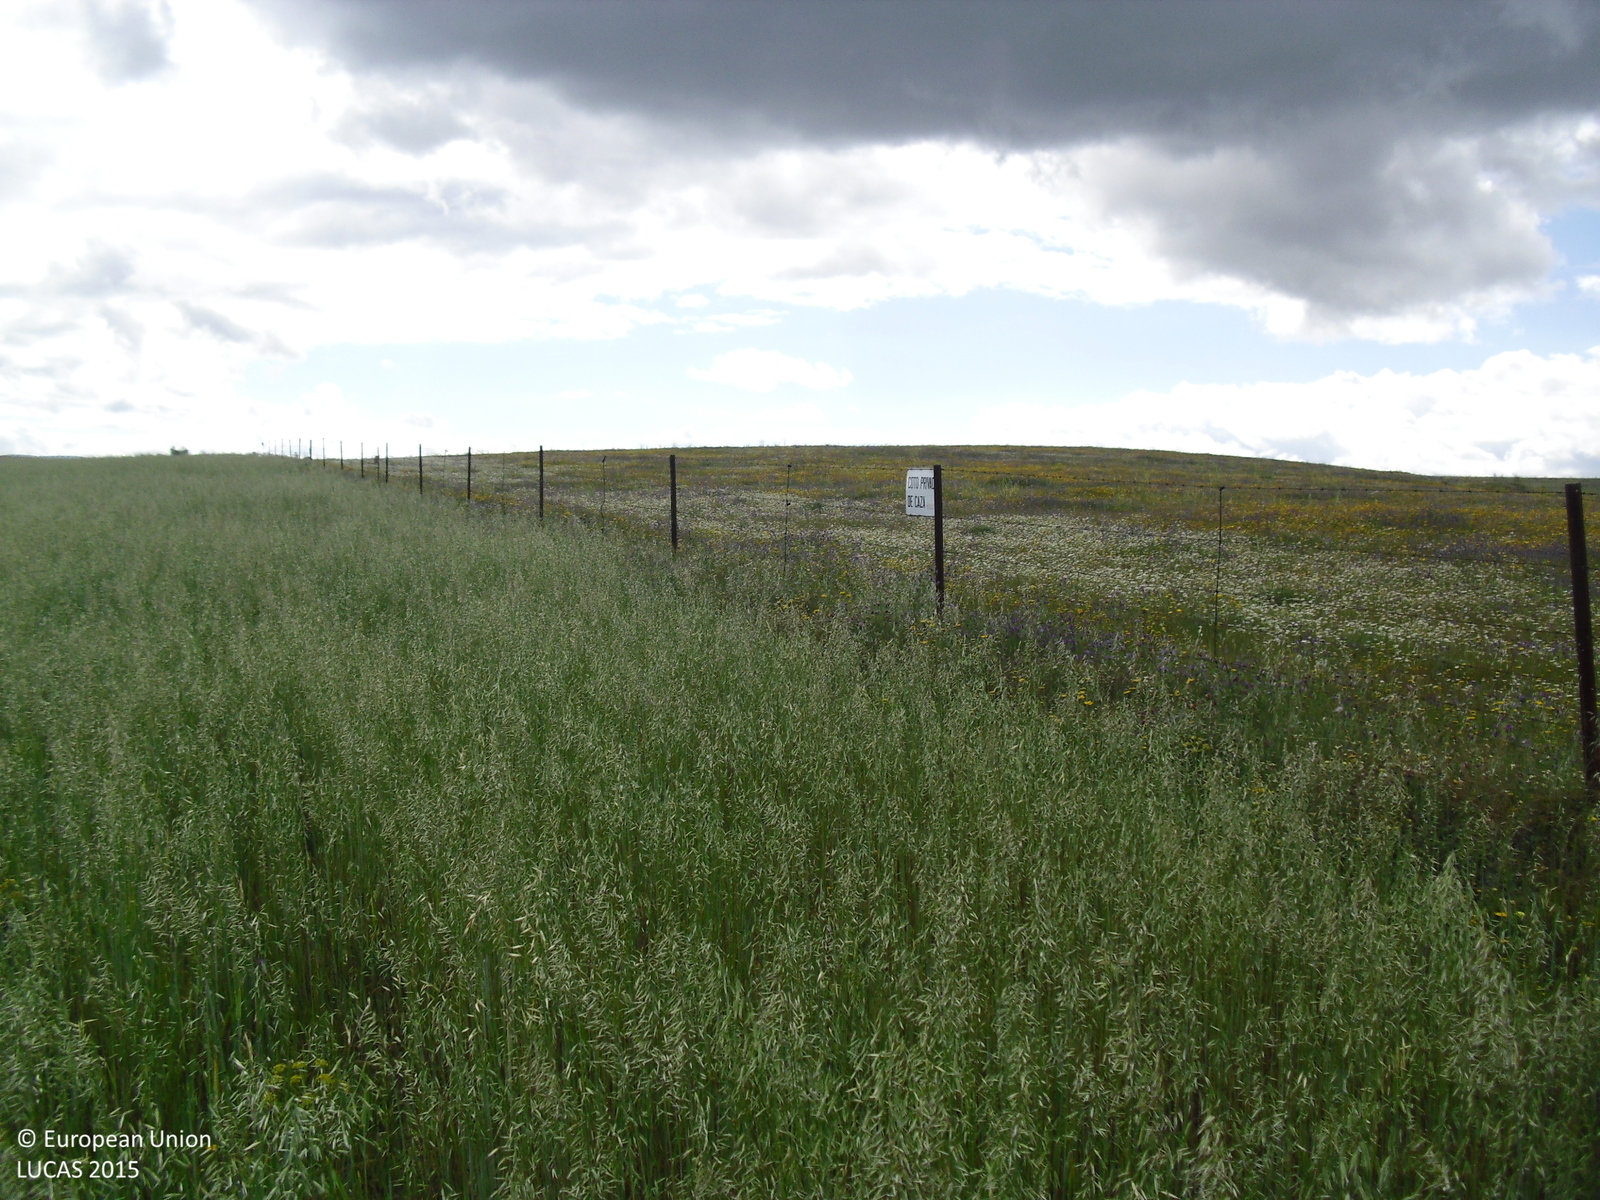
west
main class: Cropland
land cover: Oats
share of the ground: > 75 %
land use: Agriculture (excluding fallow land and kitchen gardens)
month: April
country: ES
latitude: 39.4272
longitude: -7.1489
